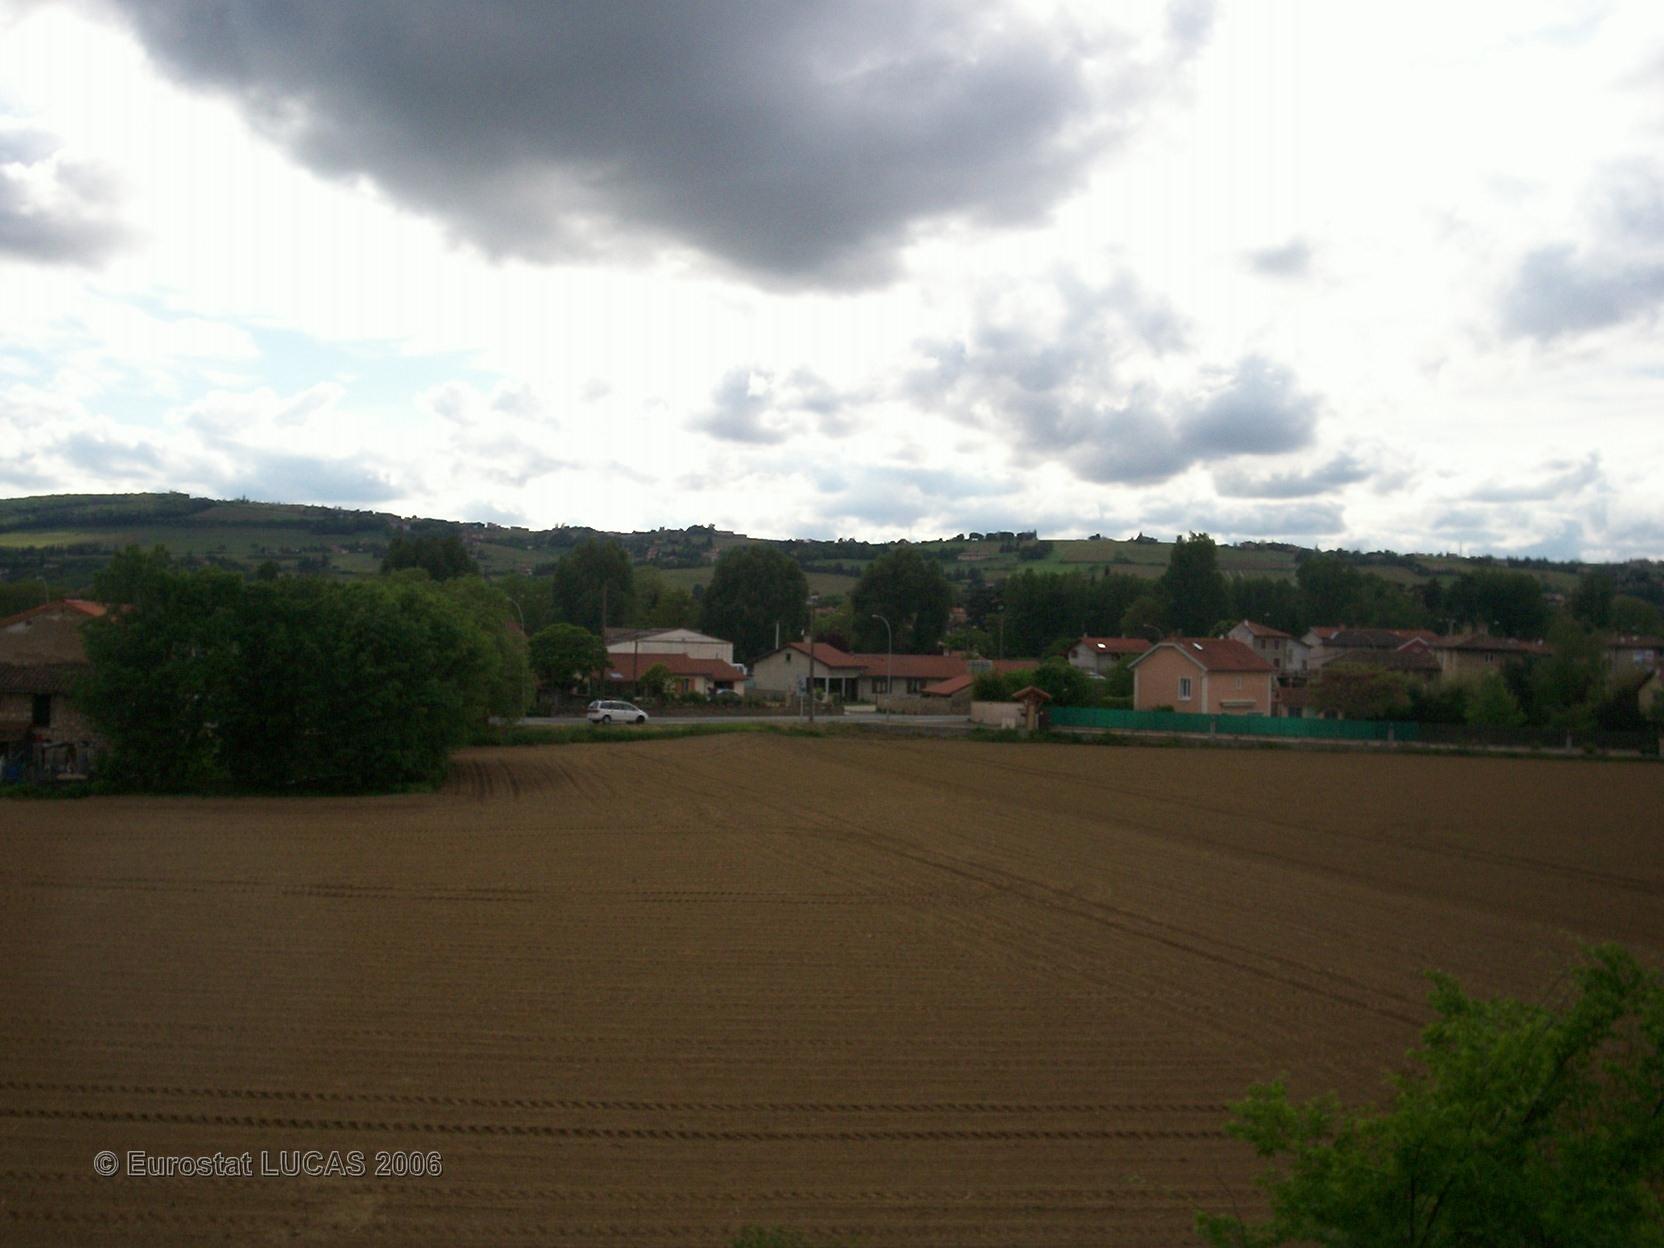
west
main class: Grassland
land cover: Grassland without tree/shrub cover
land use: Unused
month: May
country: FR
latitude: 45.9324
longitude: 4.7282
